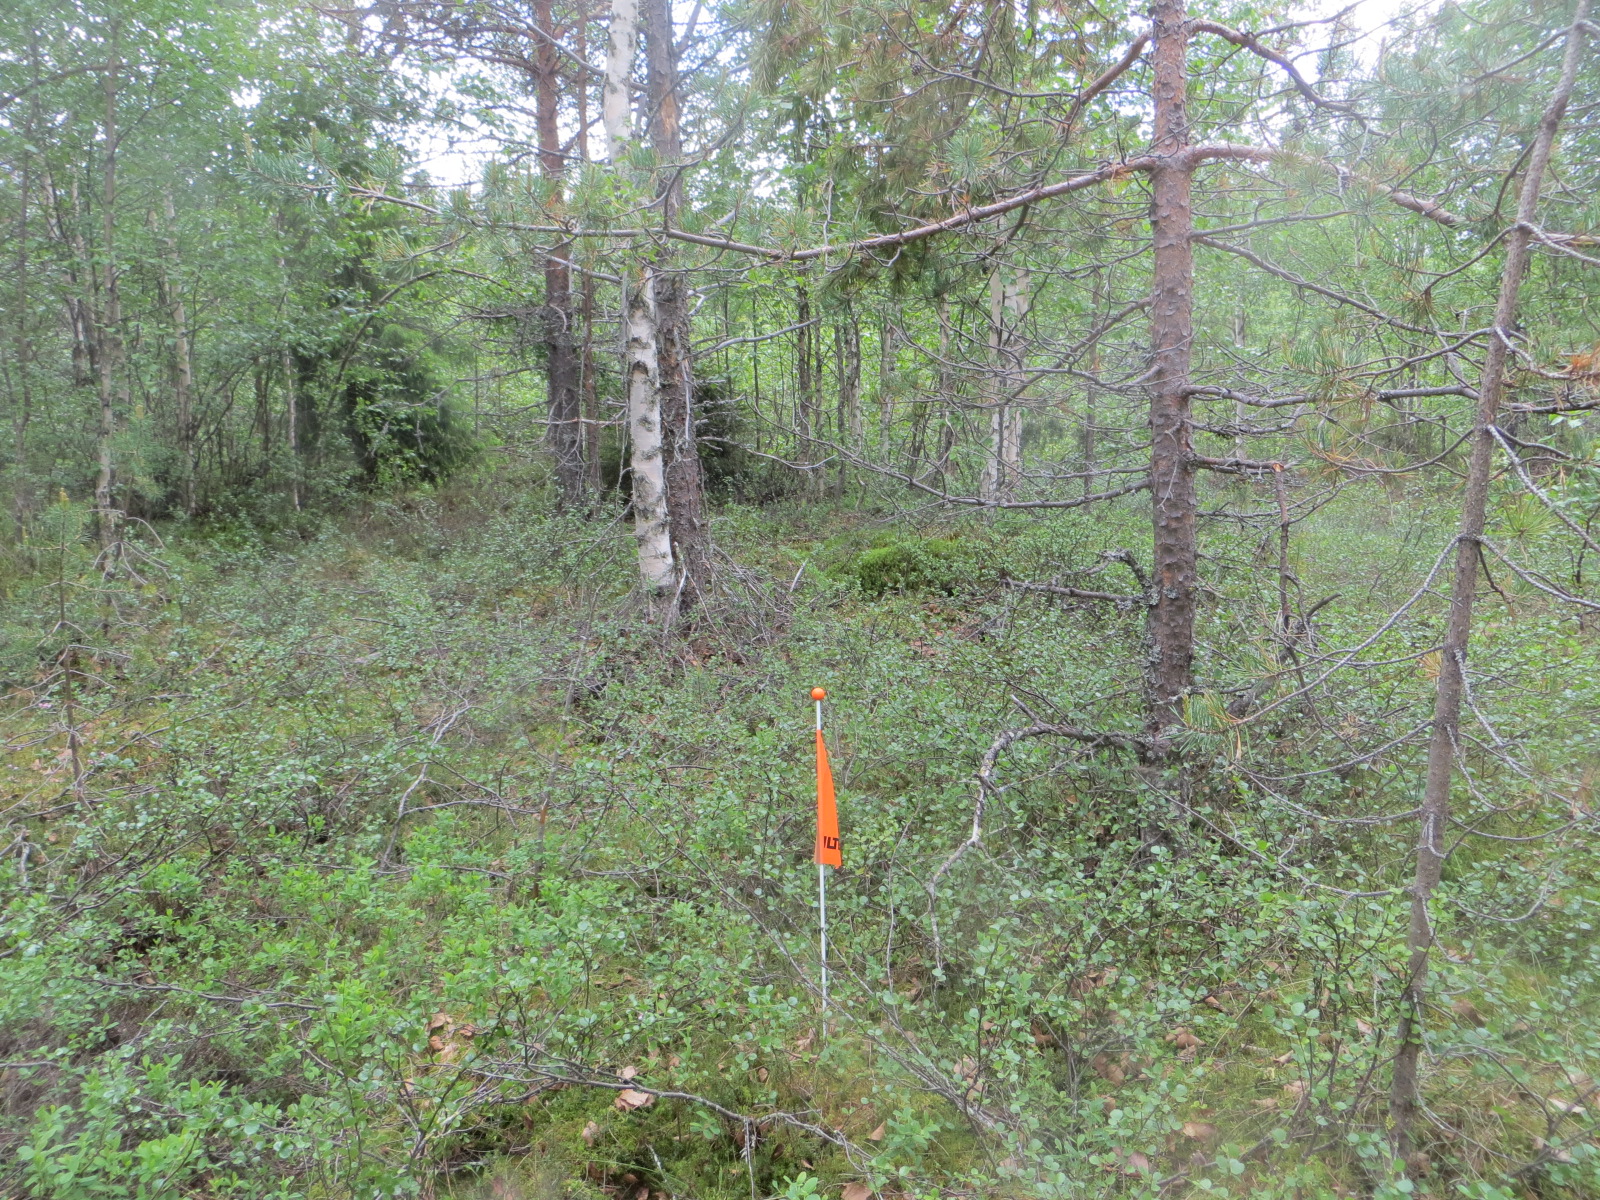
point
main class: Woodland
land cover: Pine dominated mixed woodland
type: boreal forest
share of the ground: 50 - 75 %
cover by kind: broadleaved forest trees 40 %, coniferous forest trees 30 %, shrubs 30 %
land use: Forestry
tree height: > 5 m
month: June
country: FI
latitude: 65.9673
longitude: 26.3981
